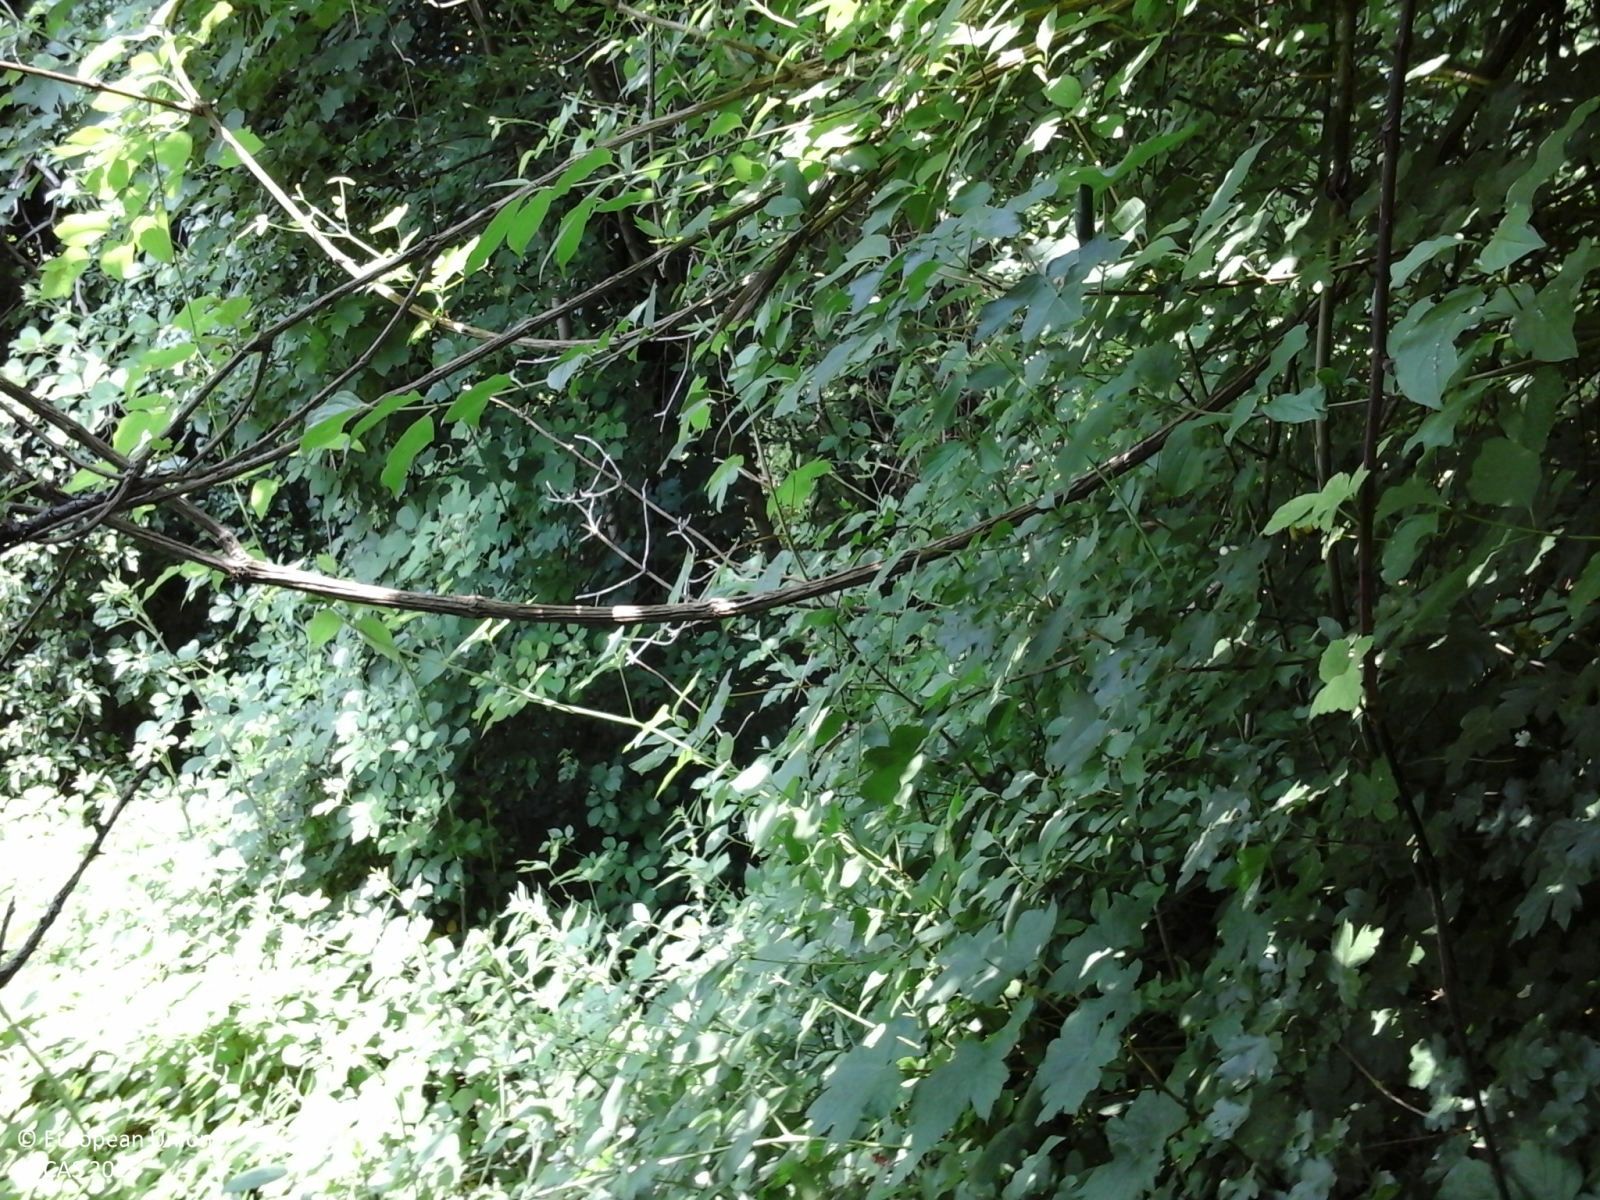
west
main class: Woodland
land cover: Broadleaved woodland
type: thermophilous deciduous forest
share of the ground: > 75 %
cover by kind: broadleaved forest trees 100 %
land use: Semi-natural and natural areas not in use
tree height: > 5 m
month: June
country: IT
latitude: 45.7810
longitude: 11.5796
